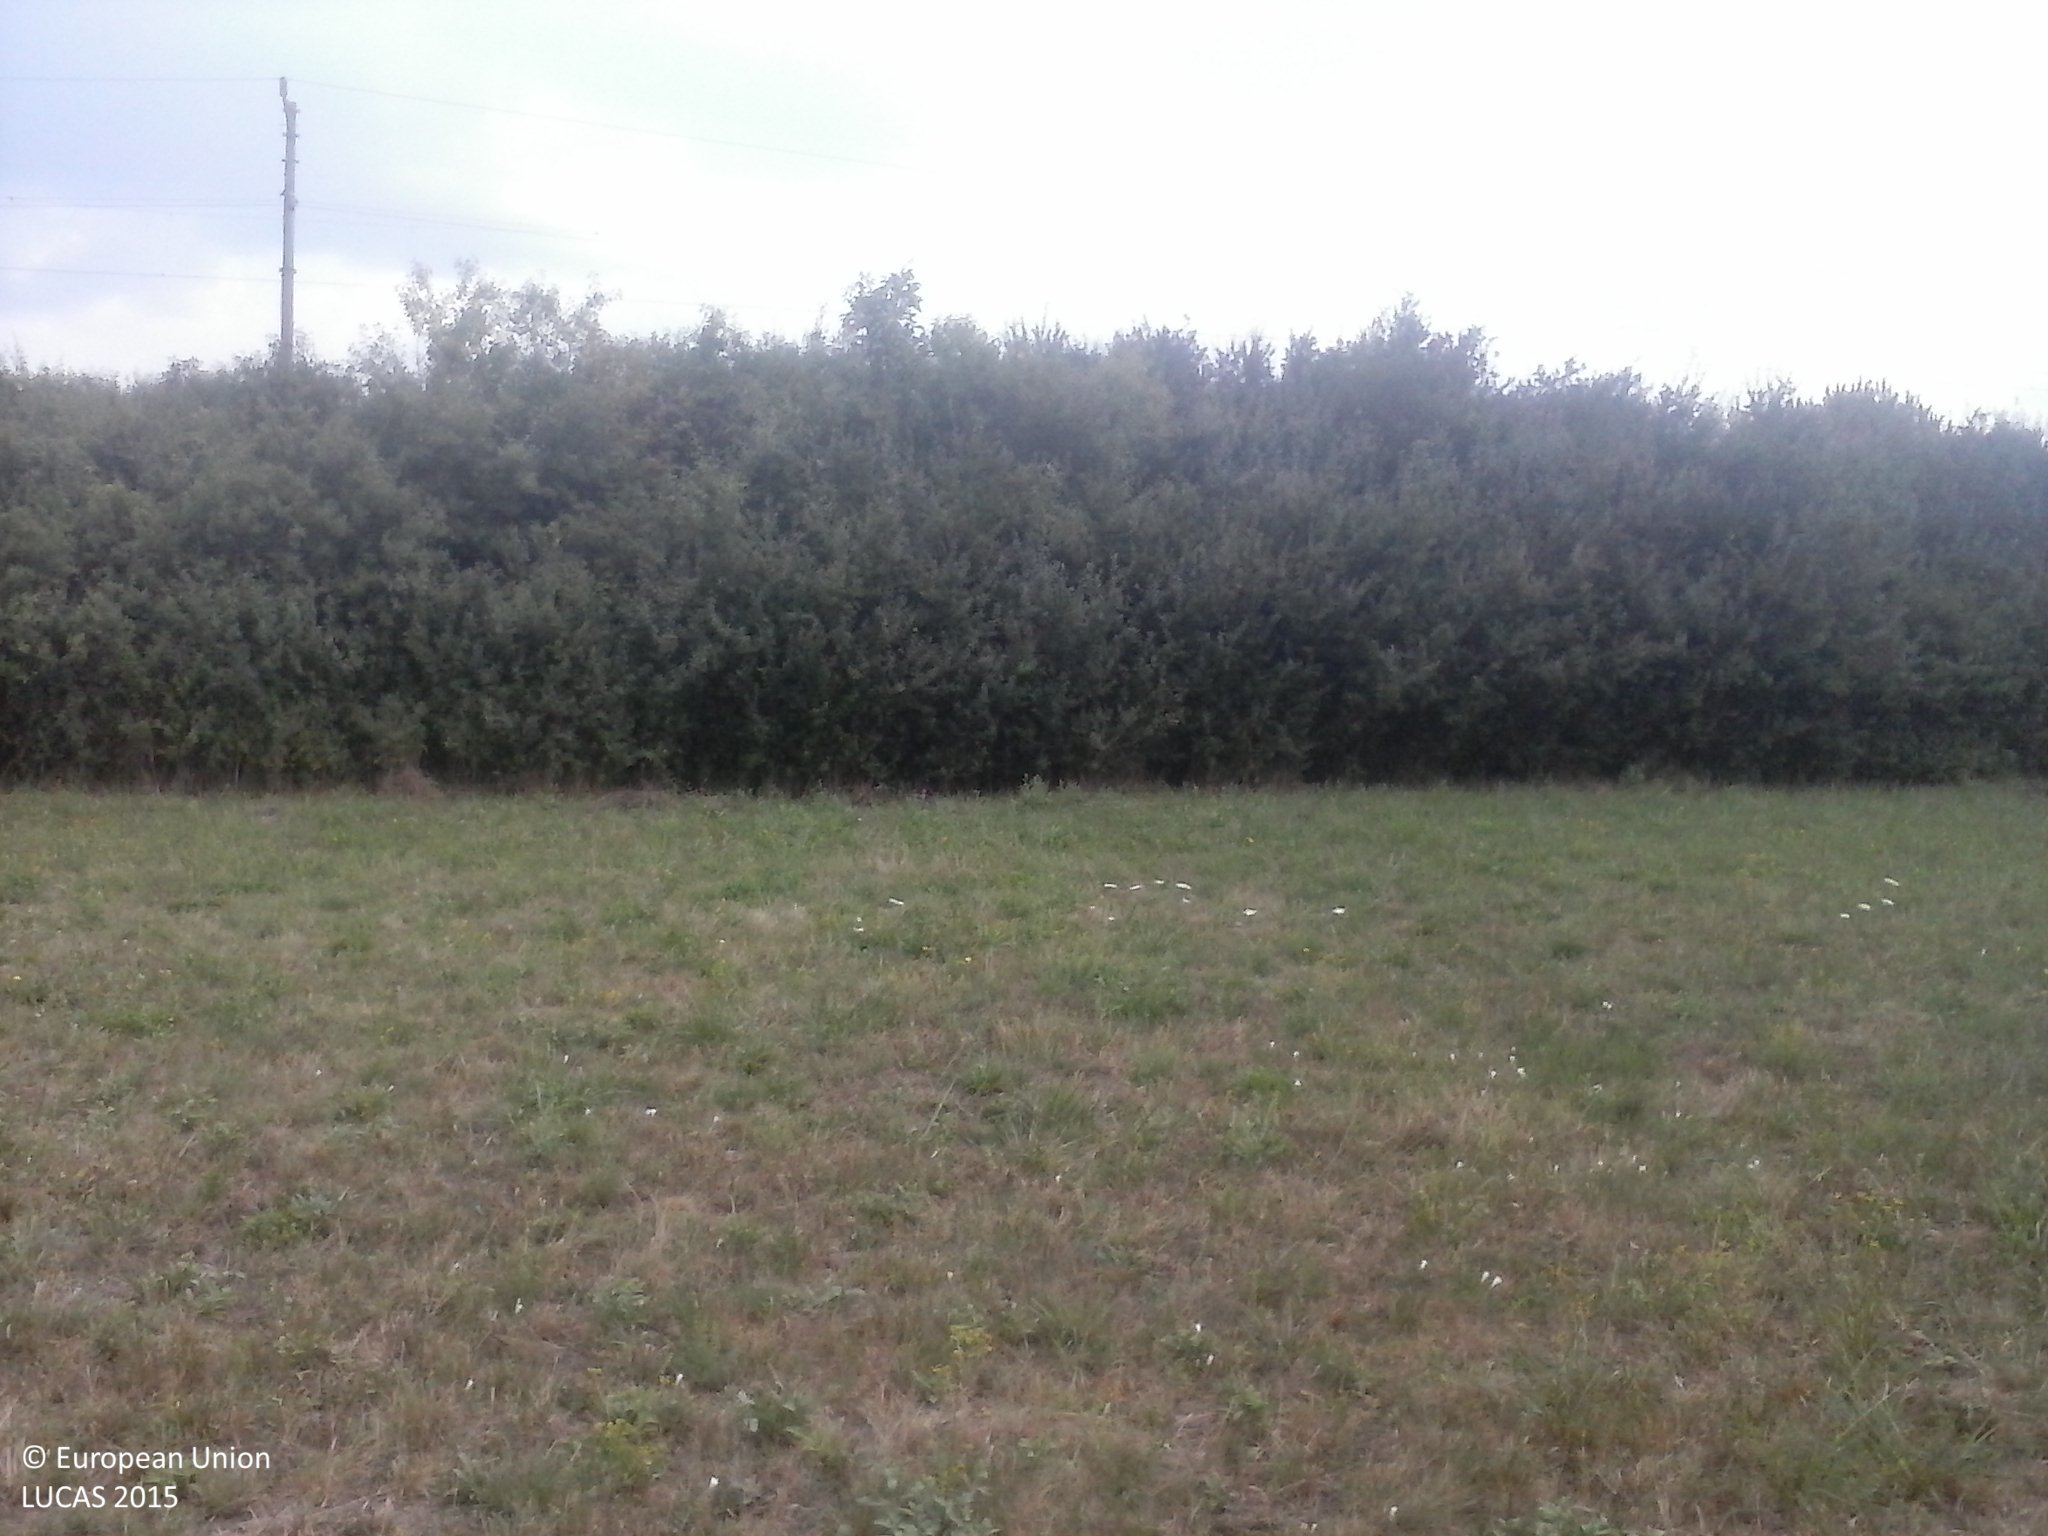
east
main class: Grassland
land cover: Grassland without tree/shrub cover
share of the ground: > 75 %
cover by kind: herbaceous plants 100 %
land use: Agriculture (excluding fallow land and kitchen gardens)
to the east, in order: Grassland without tree/shrub cover; Shrubland without tree cover; Electric lines; Railways; Shrubland without tree cover; Inland marshes; Grassland with sparse tree/shrub cover; Common wheat; Tracks; Rape and turnip rape
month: August
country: HU
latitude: 46.0527
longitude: 17.9803
